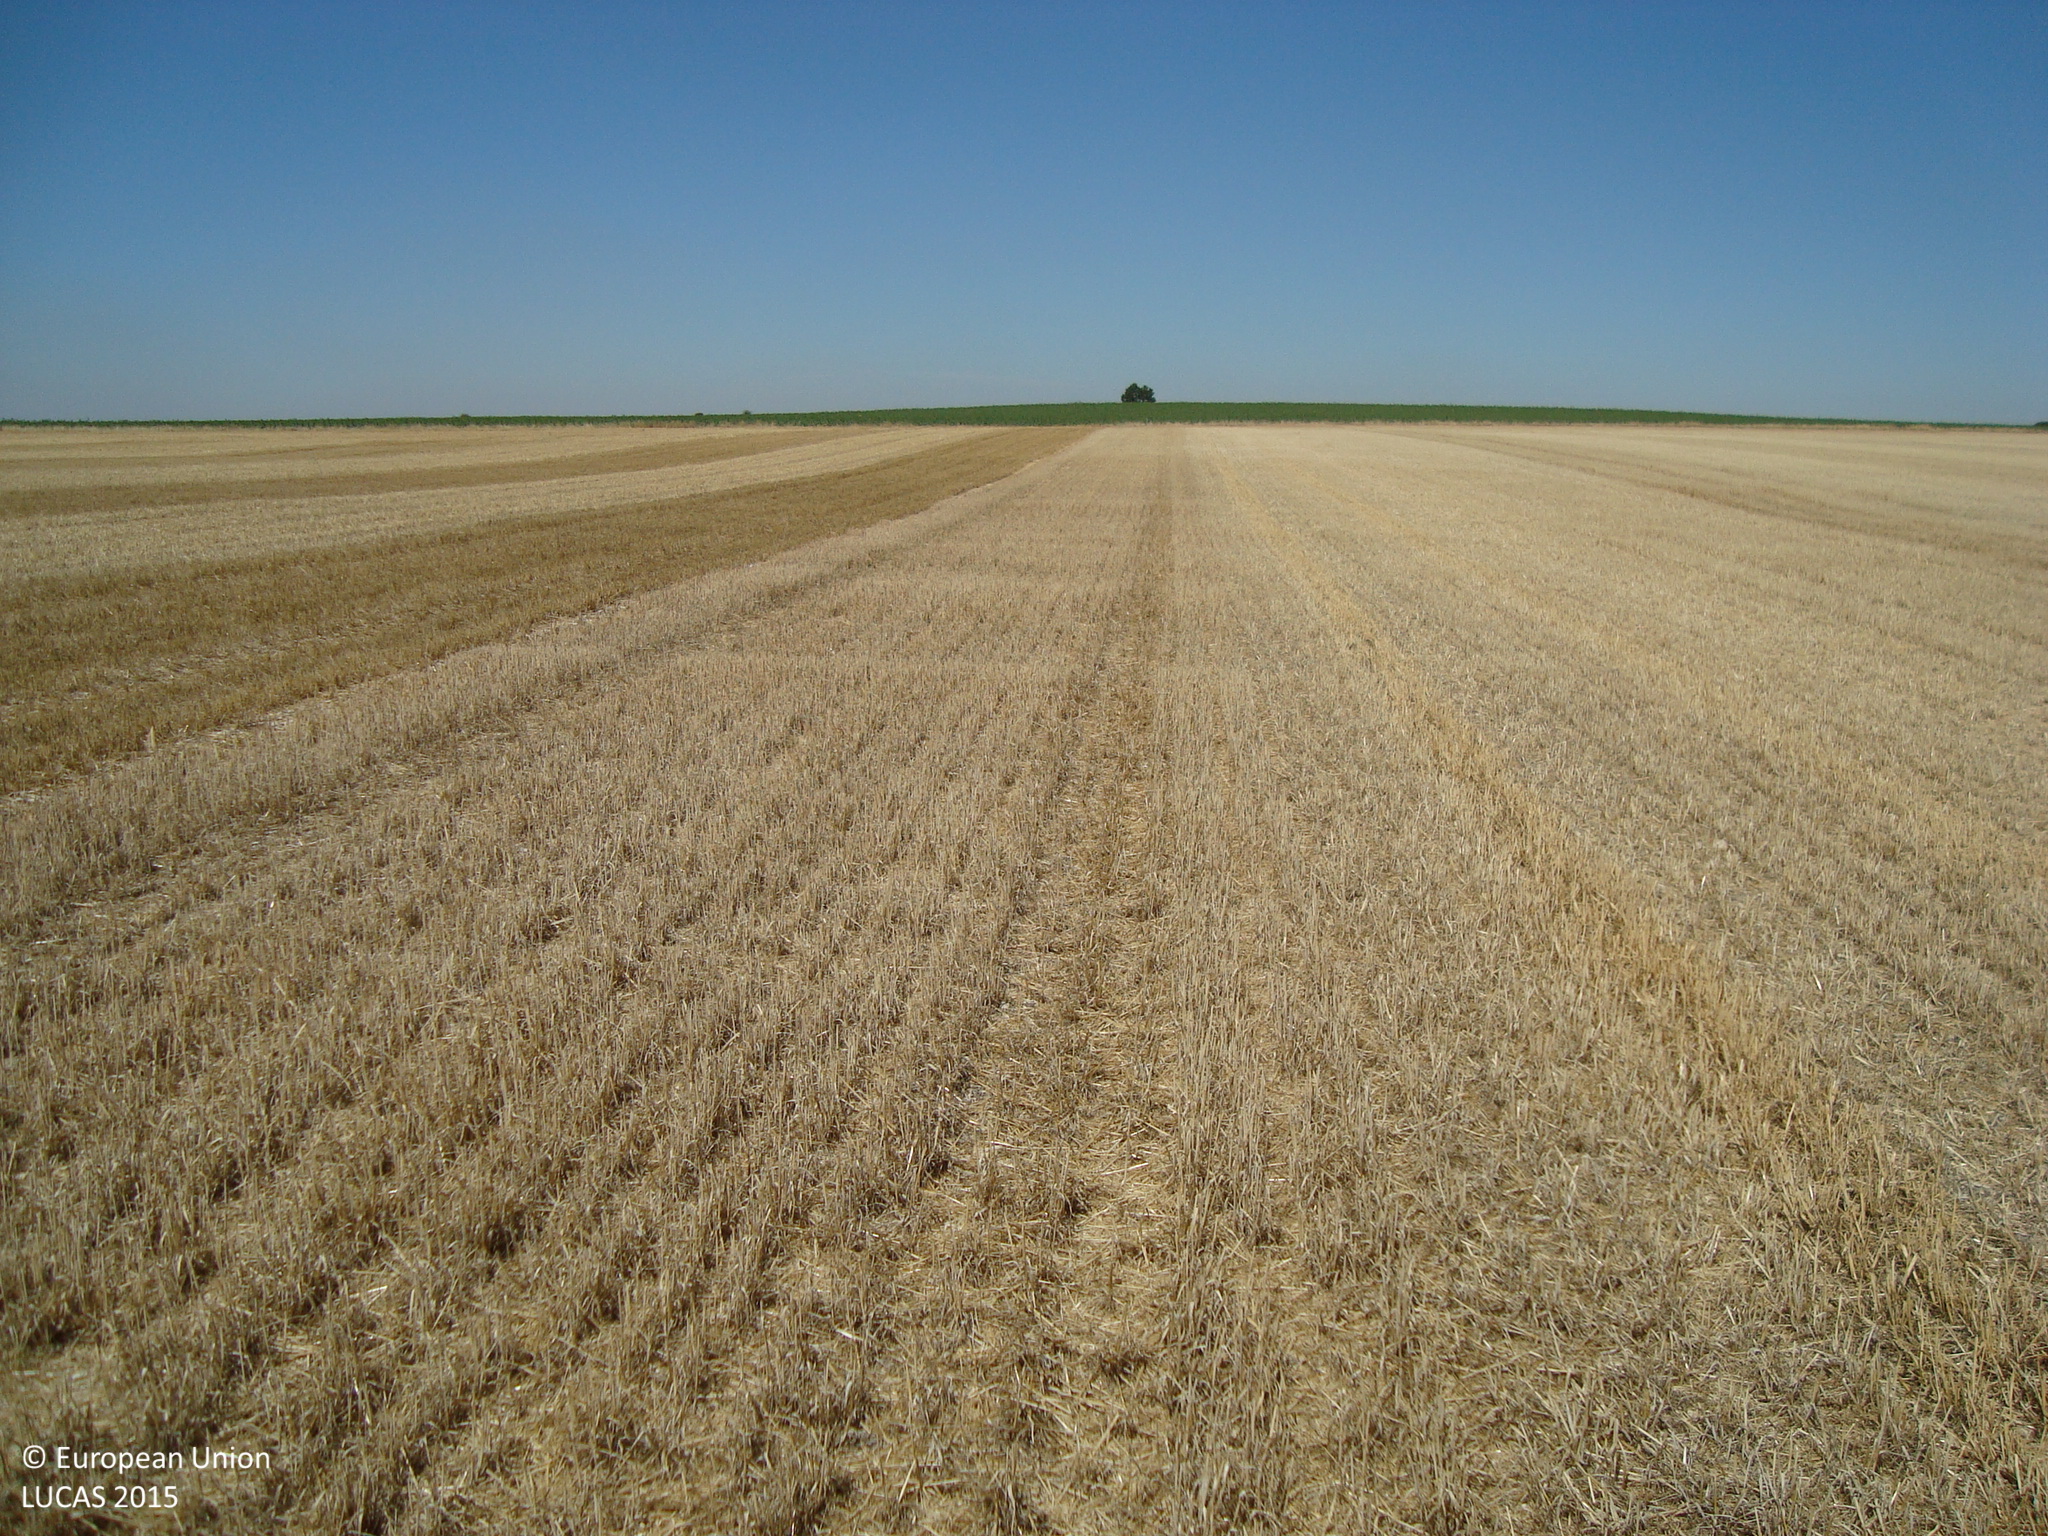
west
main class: Cropland
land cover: Barley
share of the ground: > 75 %
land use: Agriculture (excluding fallow land and kitchen gardens)
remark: Harvested field
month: July
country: ES
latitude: 41.8619
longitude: -3.8510
